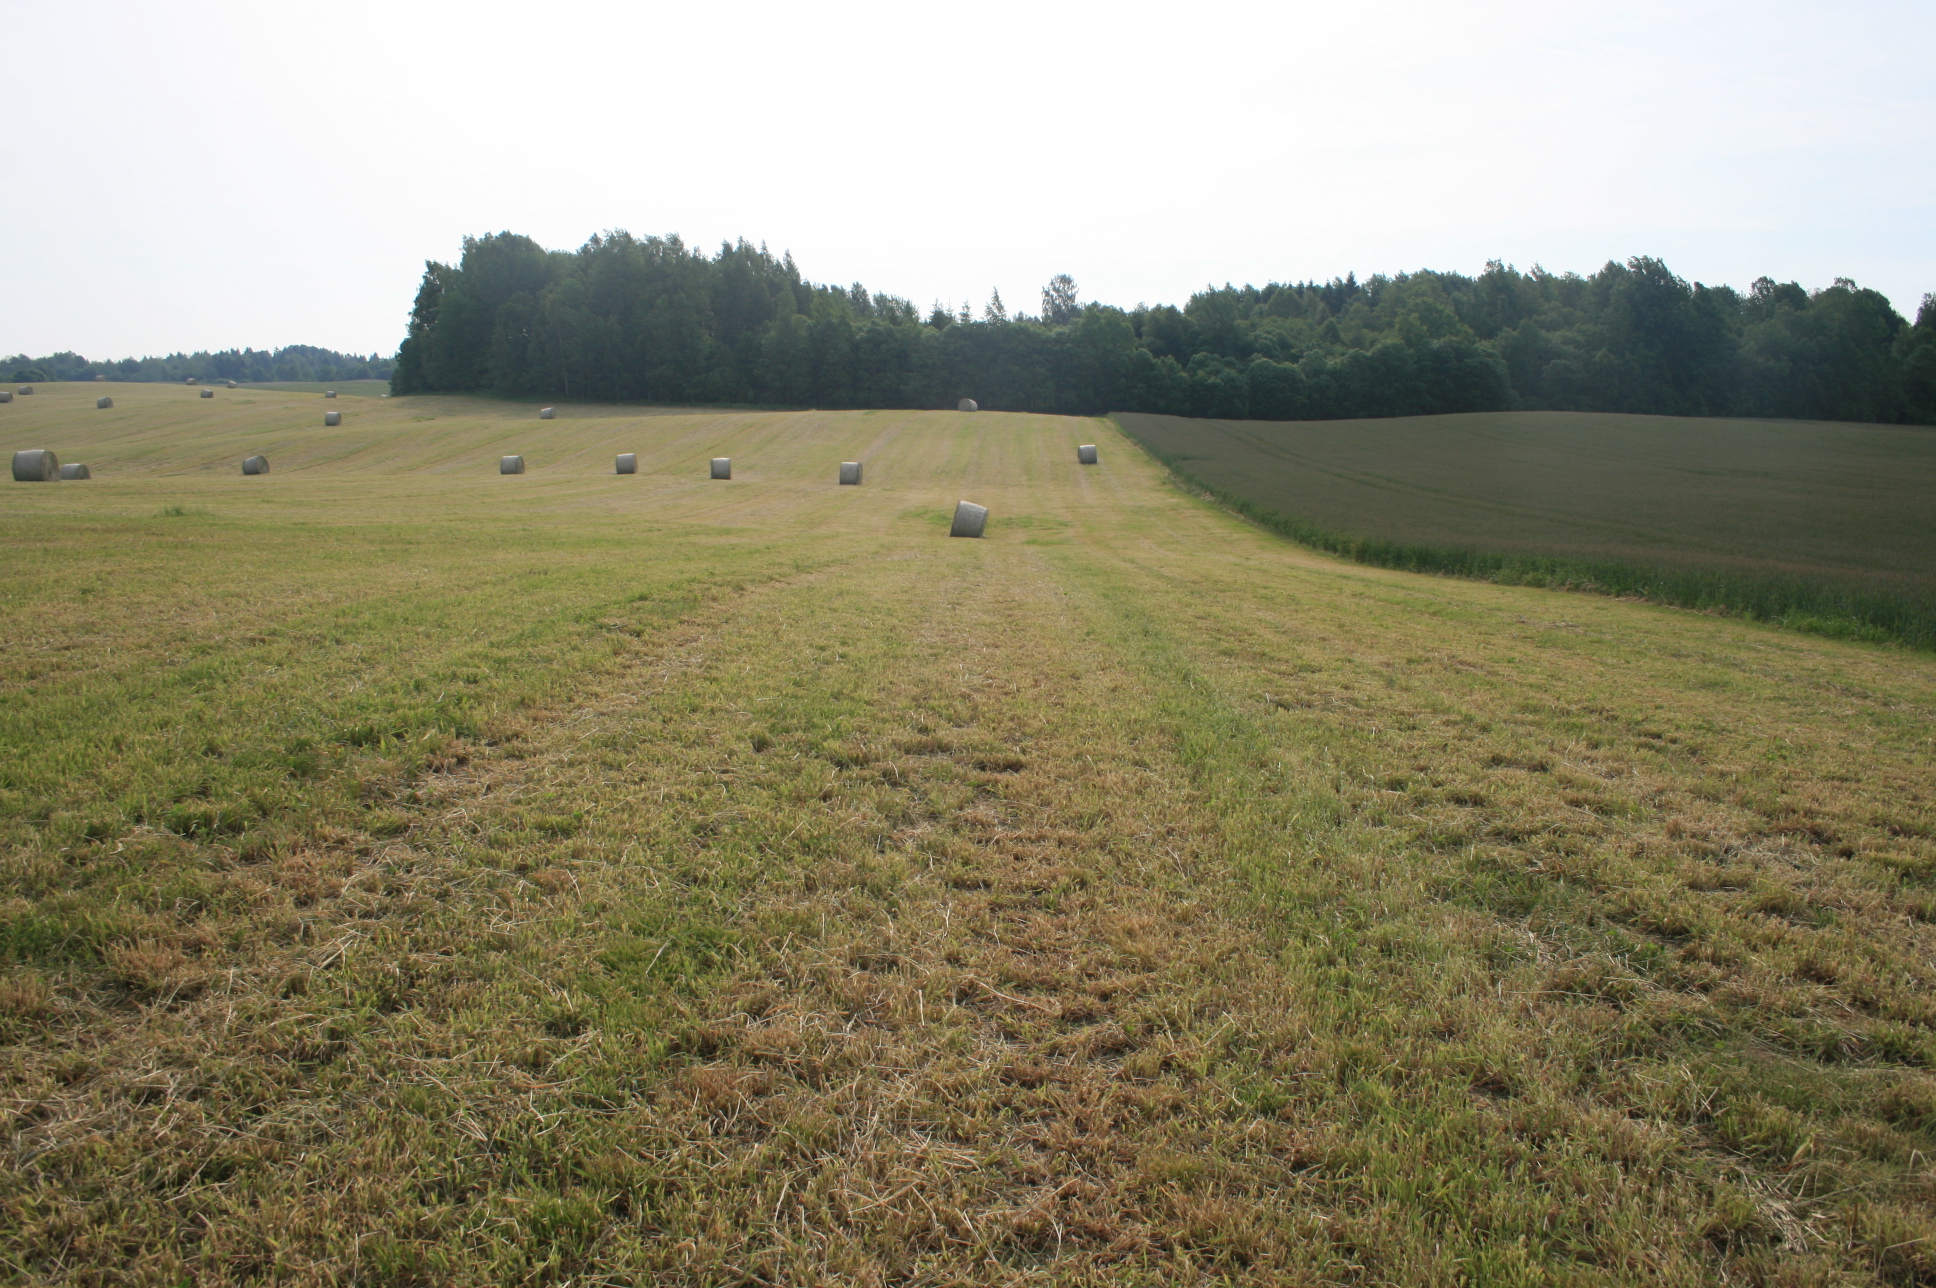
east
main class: Grassland
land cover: Grassland without tree/shrub cover
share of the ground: > 75 %
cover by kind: herbaceous plants 100 %
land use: Agriculture (excluding fallow land and kitchen gardens)
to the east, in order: Grassland without tree/shrub cover; Broadleaved woodland
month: June
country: LT
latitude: 55.7269
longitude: 22.2367
